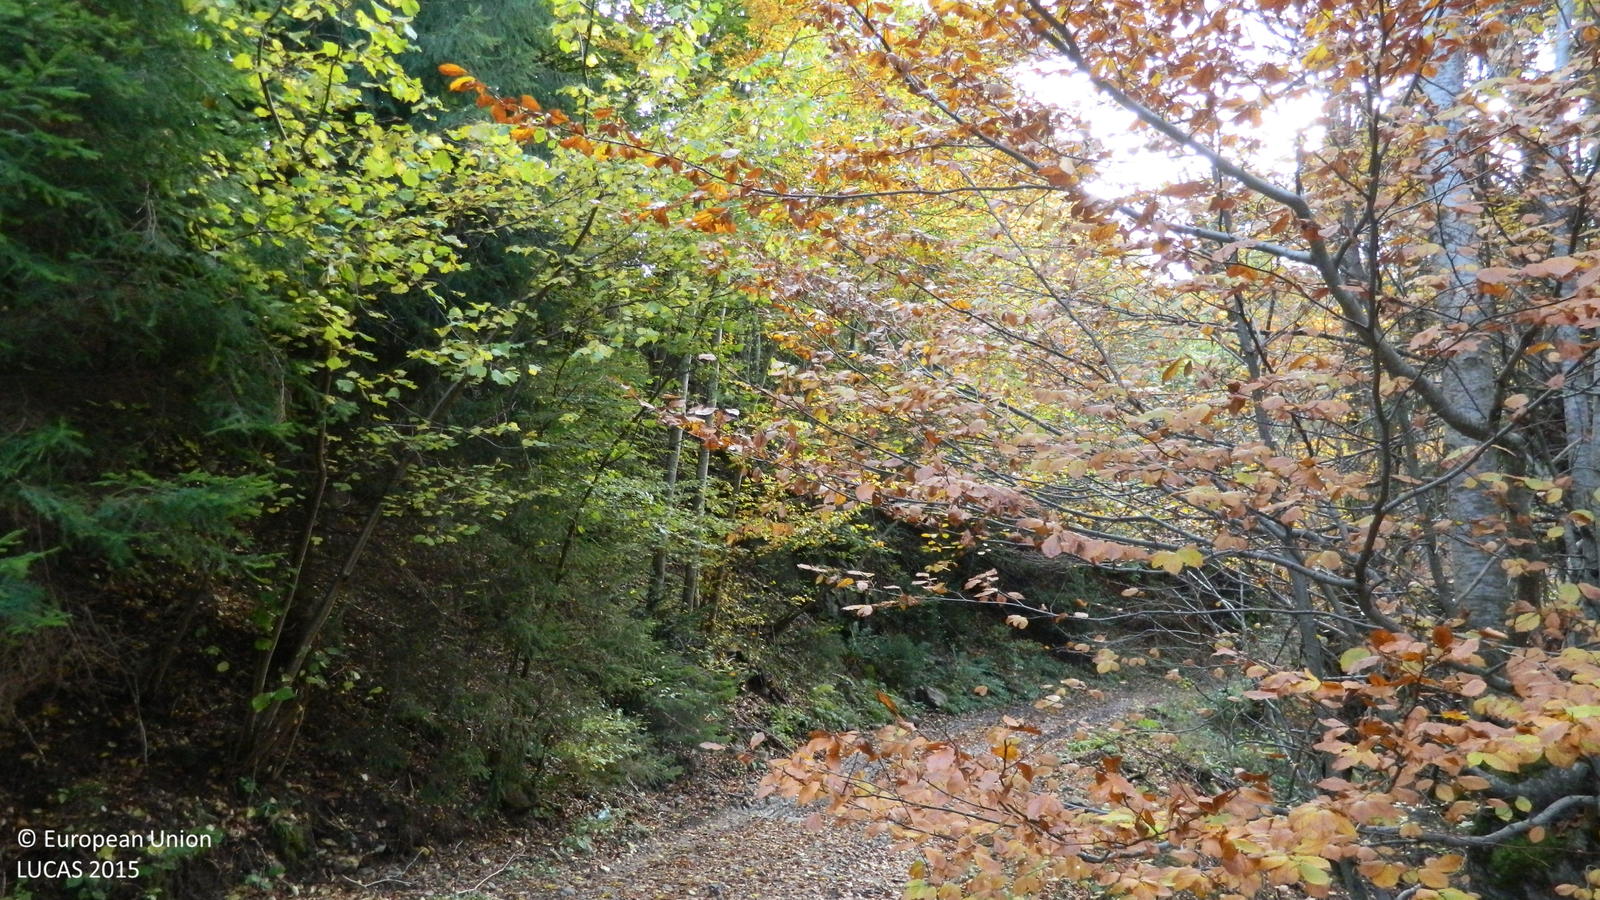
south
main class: Woodland
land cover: Pine dominated coniferous woodland
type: alpine coniferous forest
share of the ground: > 75 %
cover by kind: coniferous forest trees 90 %, unconsolidated bare surface 10 %
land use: Forestry
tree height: > 5 m
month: October
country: BG
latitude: 41.5340
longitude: 24.6042
